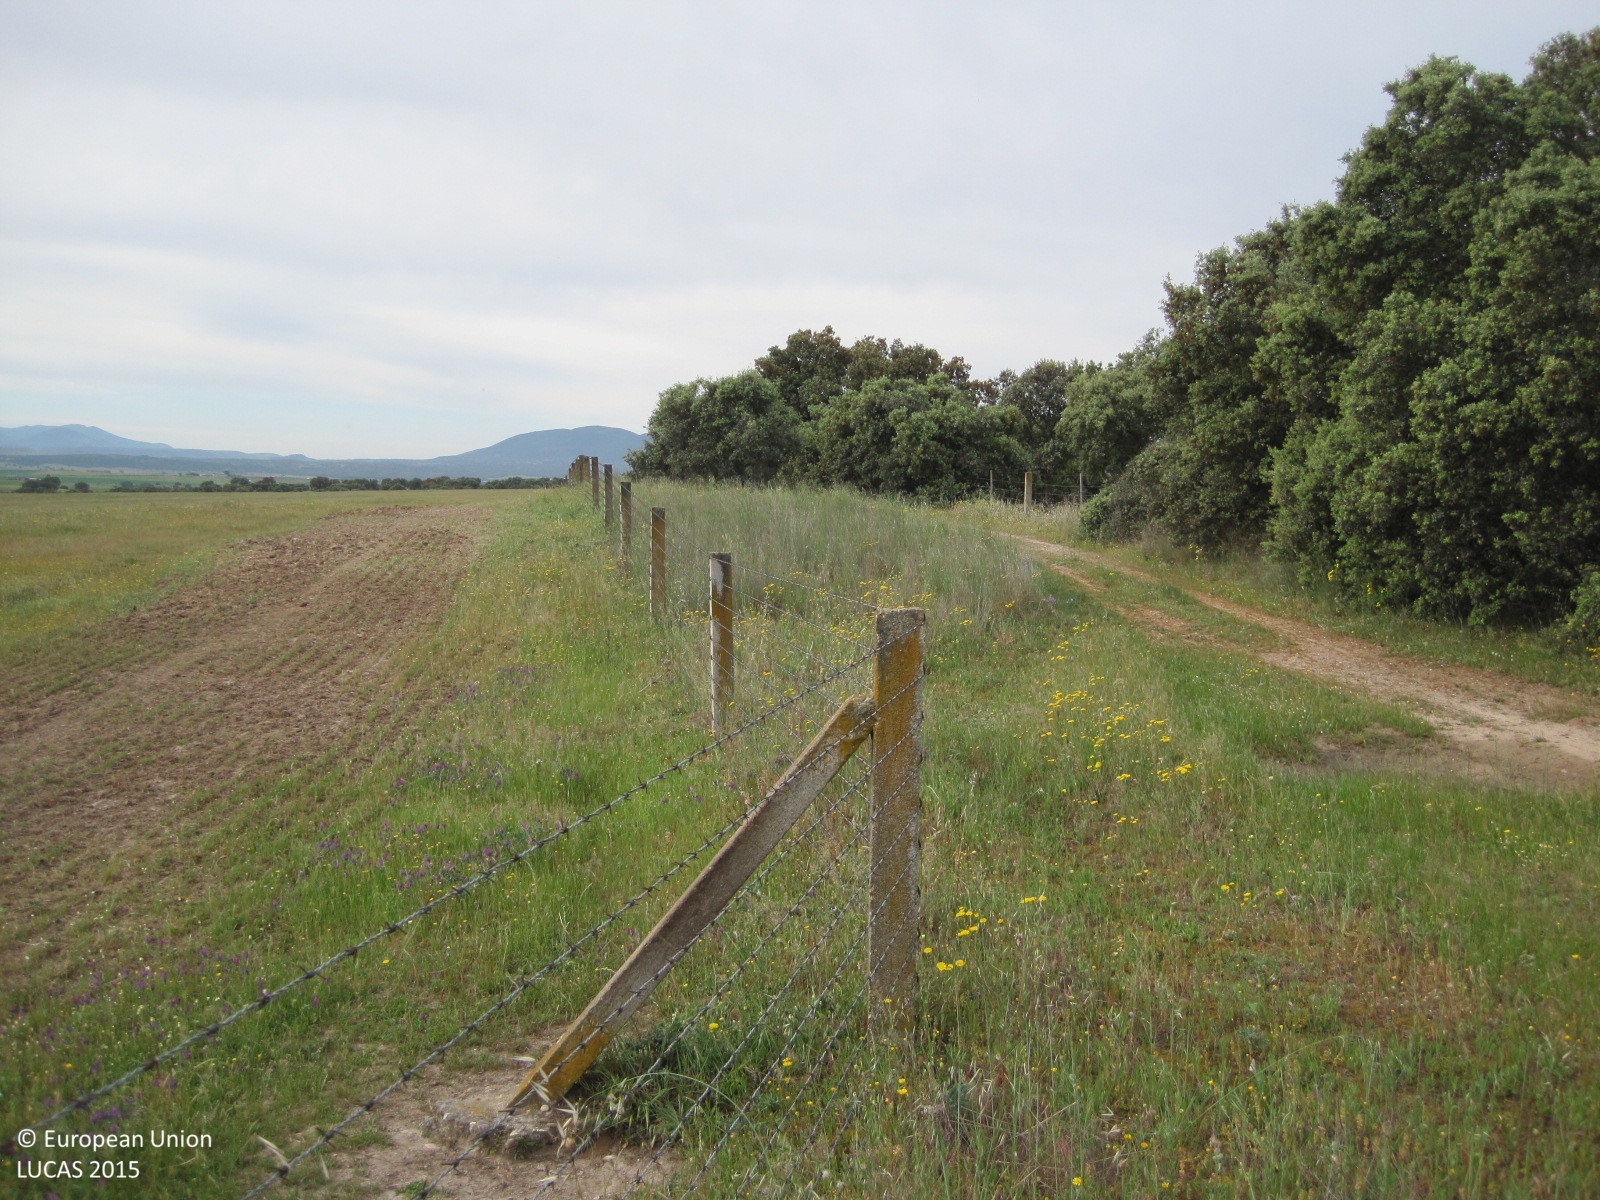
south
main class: Grassland
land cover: Grassland without tree/shrub cover
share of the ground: > 75 %
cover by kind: herbaceous plants 100 %
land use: Agriculture (excluding fallow land and kitchen gardens)
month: May
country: ES
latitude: 39.8597
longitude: -5.1186
